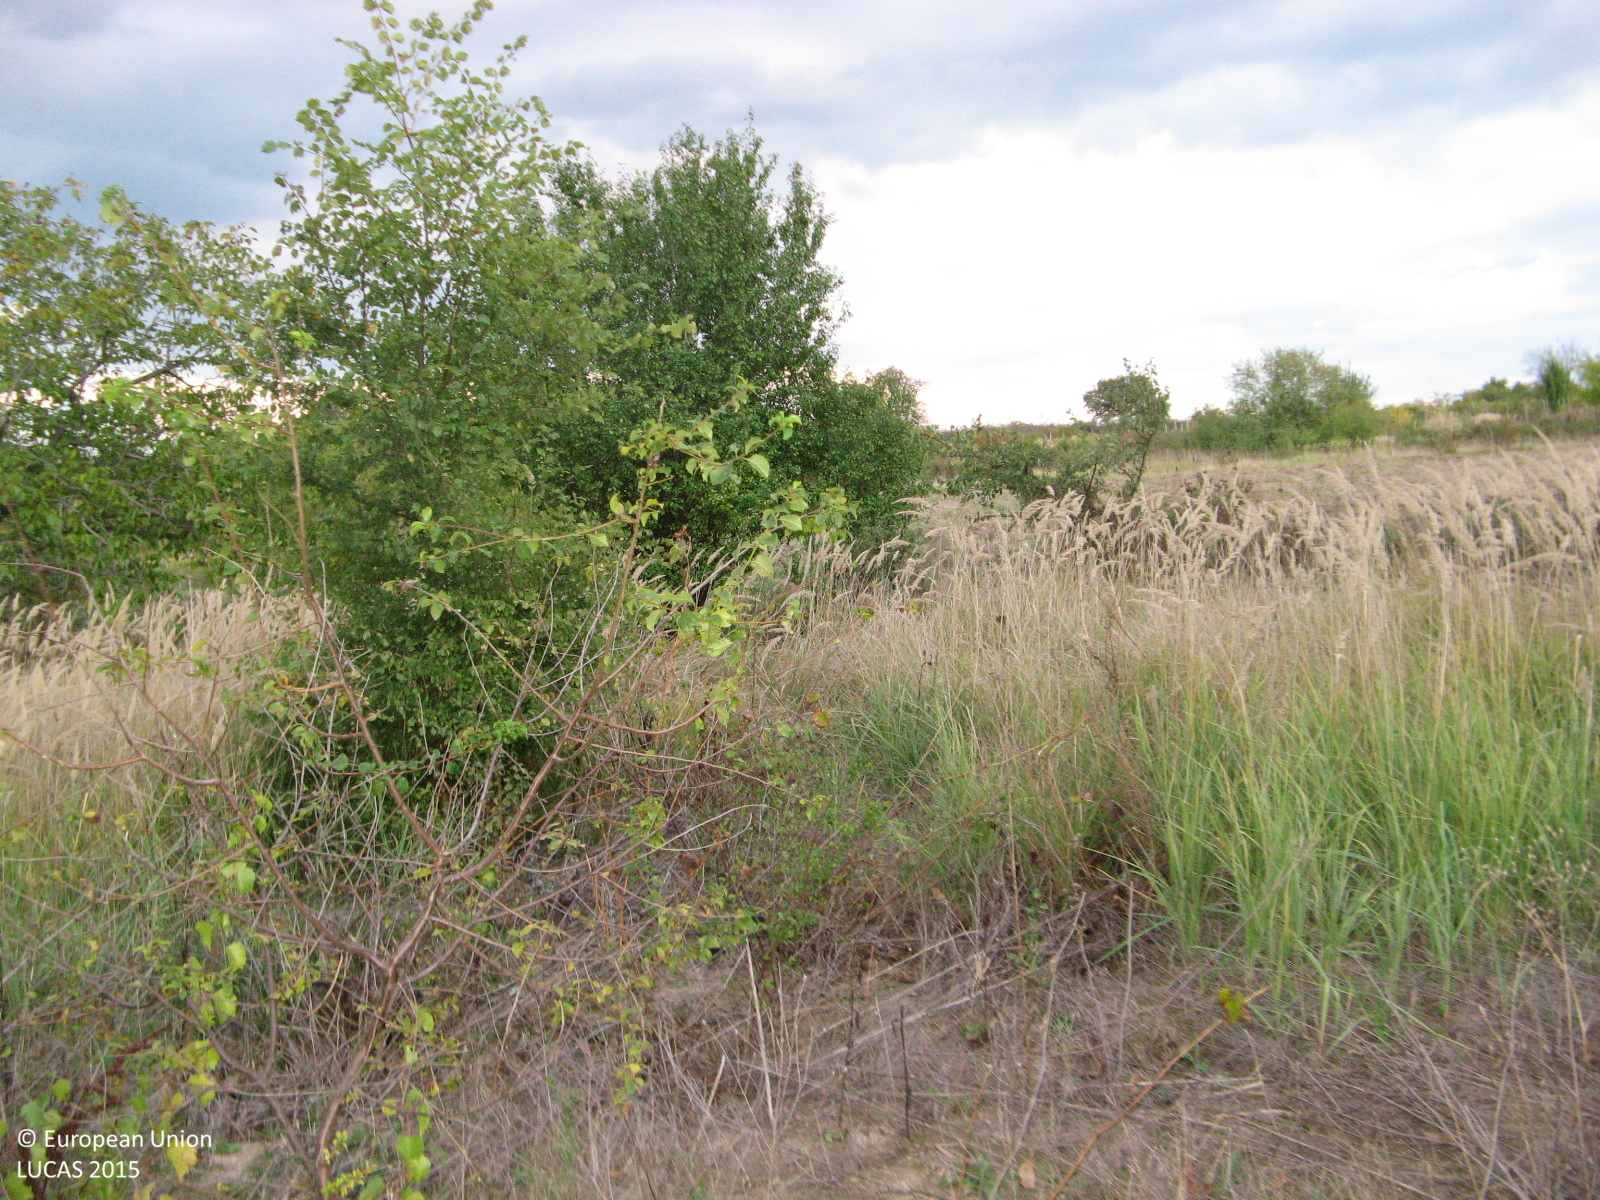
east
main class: Grassland
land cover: Grassland with sparse tree/shrub cover
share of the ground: > 75 %
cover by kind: herbaceous plants 85 %, shrubs 10 %, broadleaved forest trees 5 %
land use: Fallow land
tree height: > 5 m
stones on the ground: < 10 %
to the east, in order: Grassland with sparse tree/shrub cover; Tracks; Grass margins; Other bare soil; Grassland with sparse tree/shrub cover; Shrubland with sparse tree cover; Tracks; Shrubland with sparse tree cover; Spontaneously vegetated surfaces
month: October
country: BG
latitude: 41.9537
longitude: 25.3455
